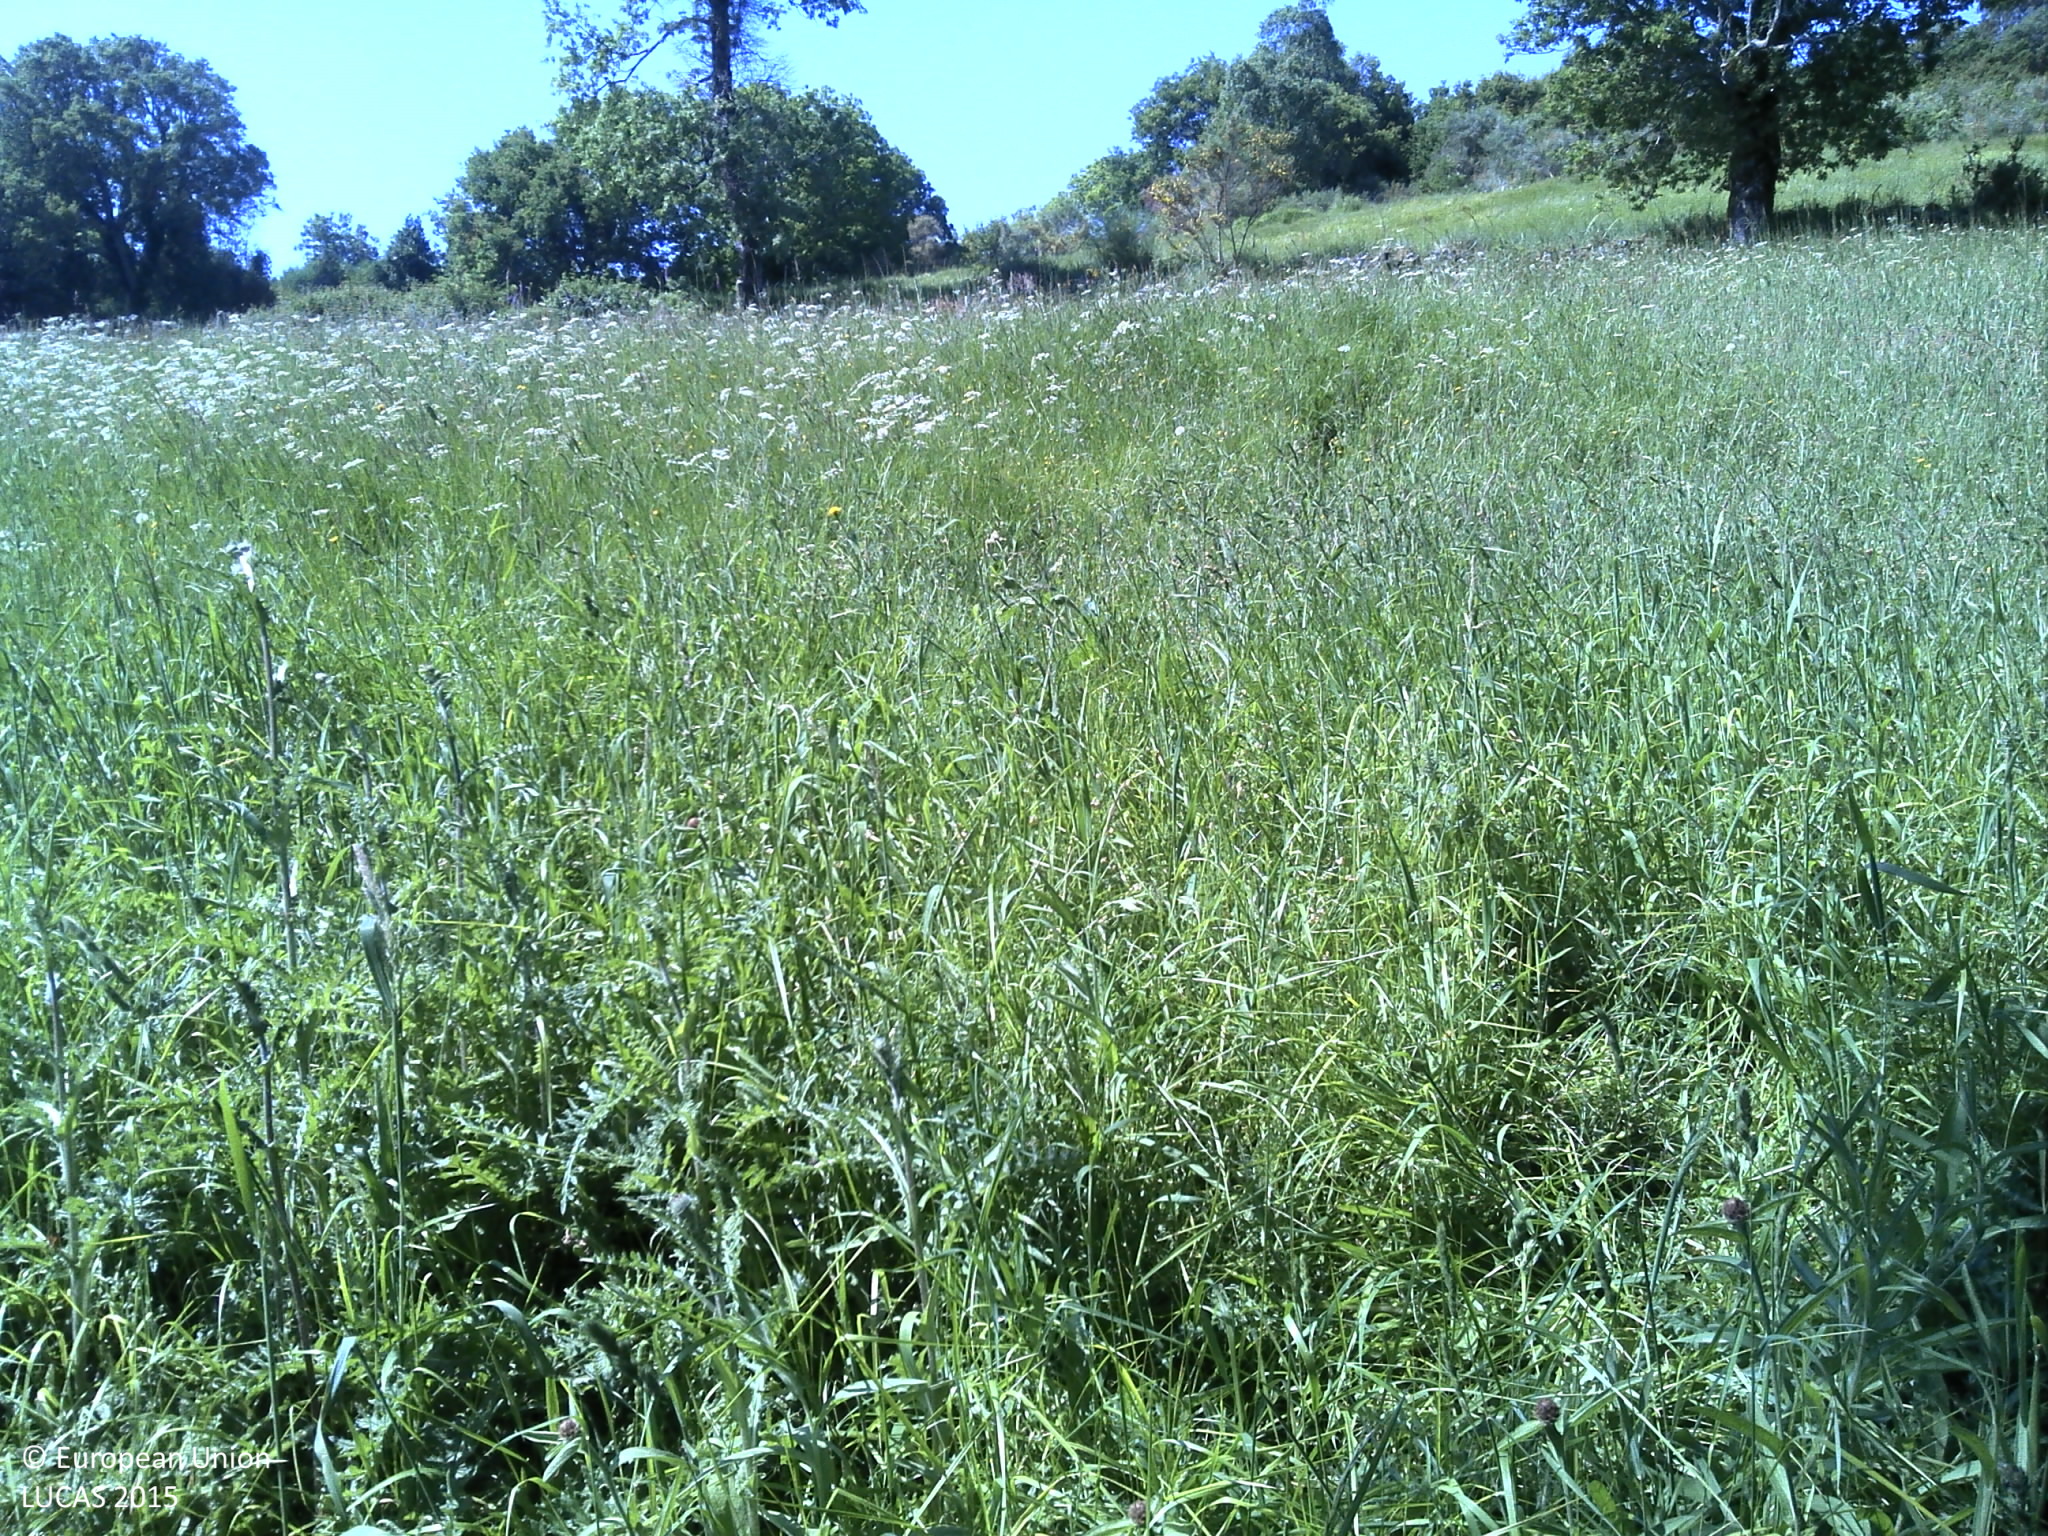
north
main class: Woodland
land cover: Broadleaved woodland
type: floodplain forest
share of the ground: 50 - 75 %
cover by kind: broadleaved forest trees 70 %, herbaceous plants 20 %, shrubs 5 %, unconsolidated bare surface 5 %
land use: Forestry
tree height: > 5 m
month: June
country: PT
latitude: 42.0515
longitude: -8.2441
